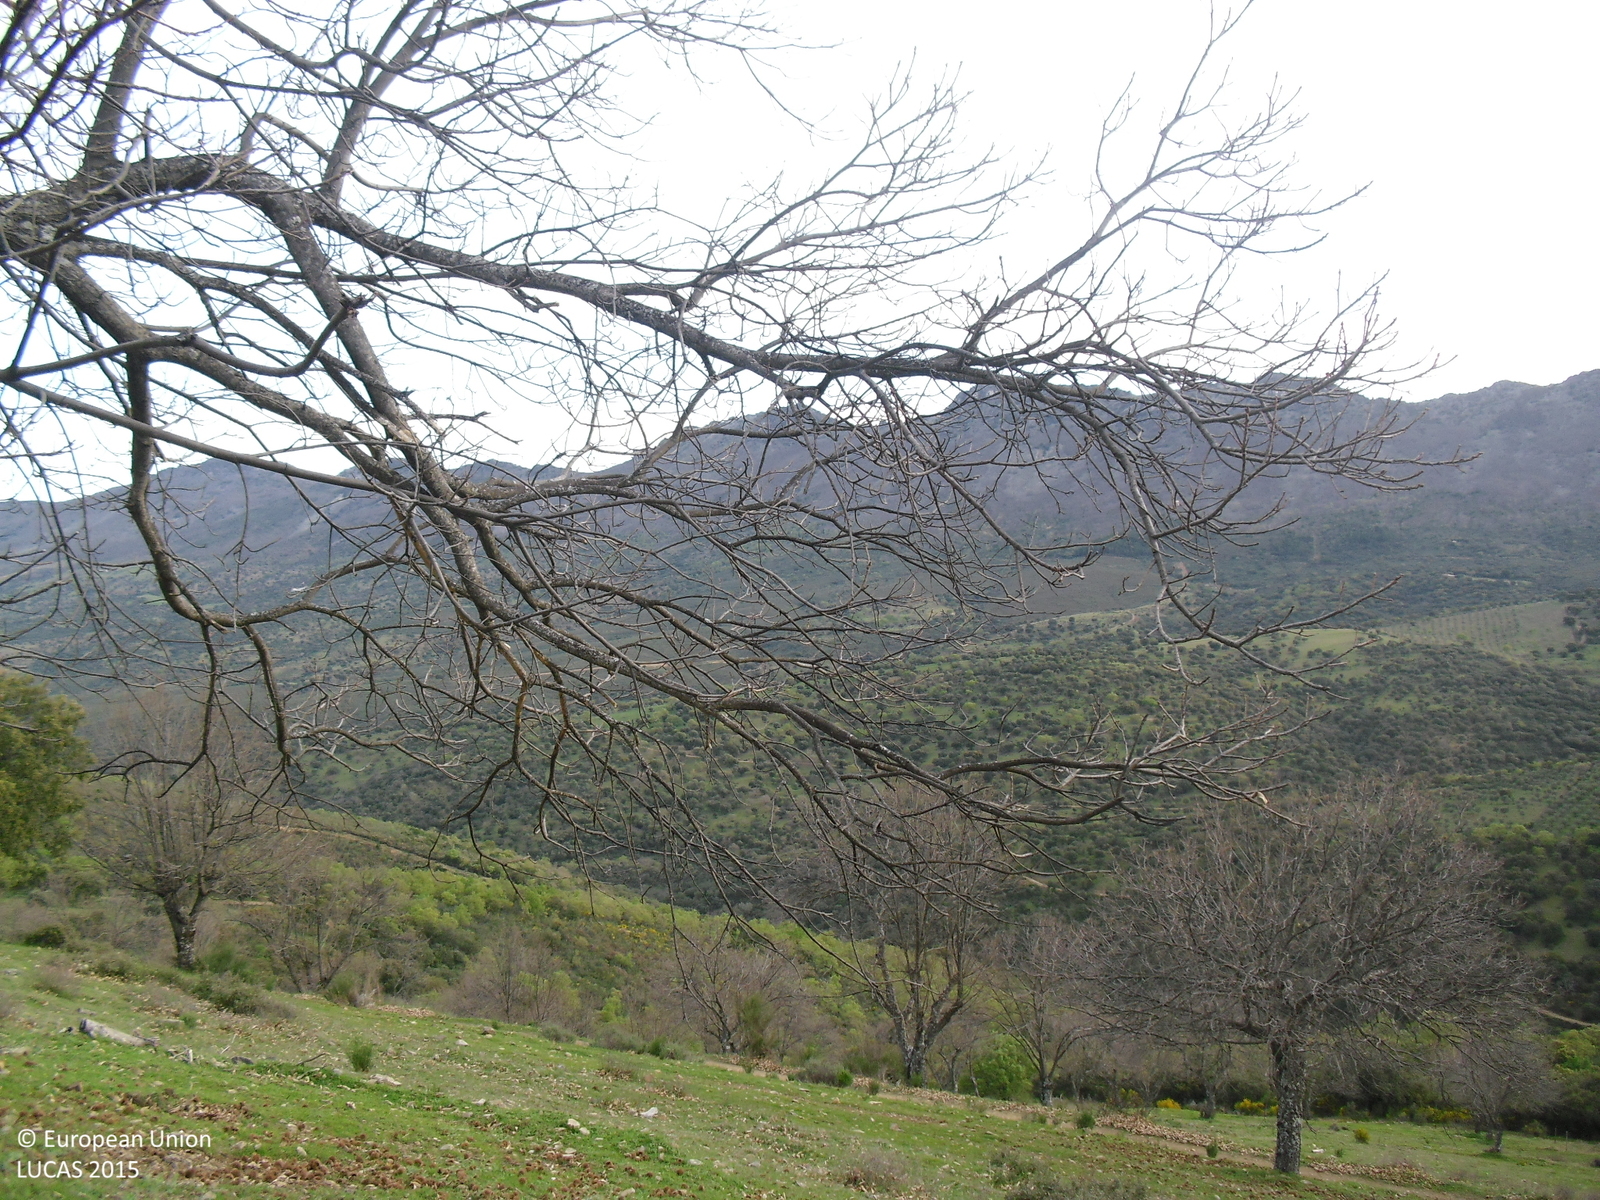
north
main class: Woodland
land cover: Broadleaved woodland
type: thermophilous deciduous forest
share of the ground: 25 - 50 %
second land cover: Grassland without tree/shrub cover
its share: > 75 %
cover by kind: herbaceous plants 60 %, broadleaved forest trees 40 %
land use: Forestry
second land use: Agriculture (excluding fallow land and kitchen gardens)
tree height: > 5 m
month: April
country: ES
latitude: 39.5154
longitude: -5.3212
